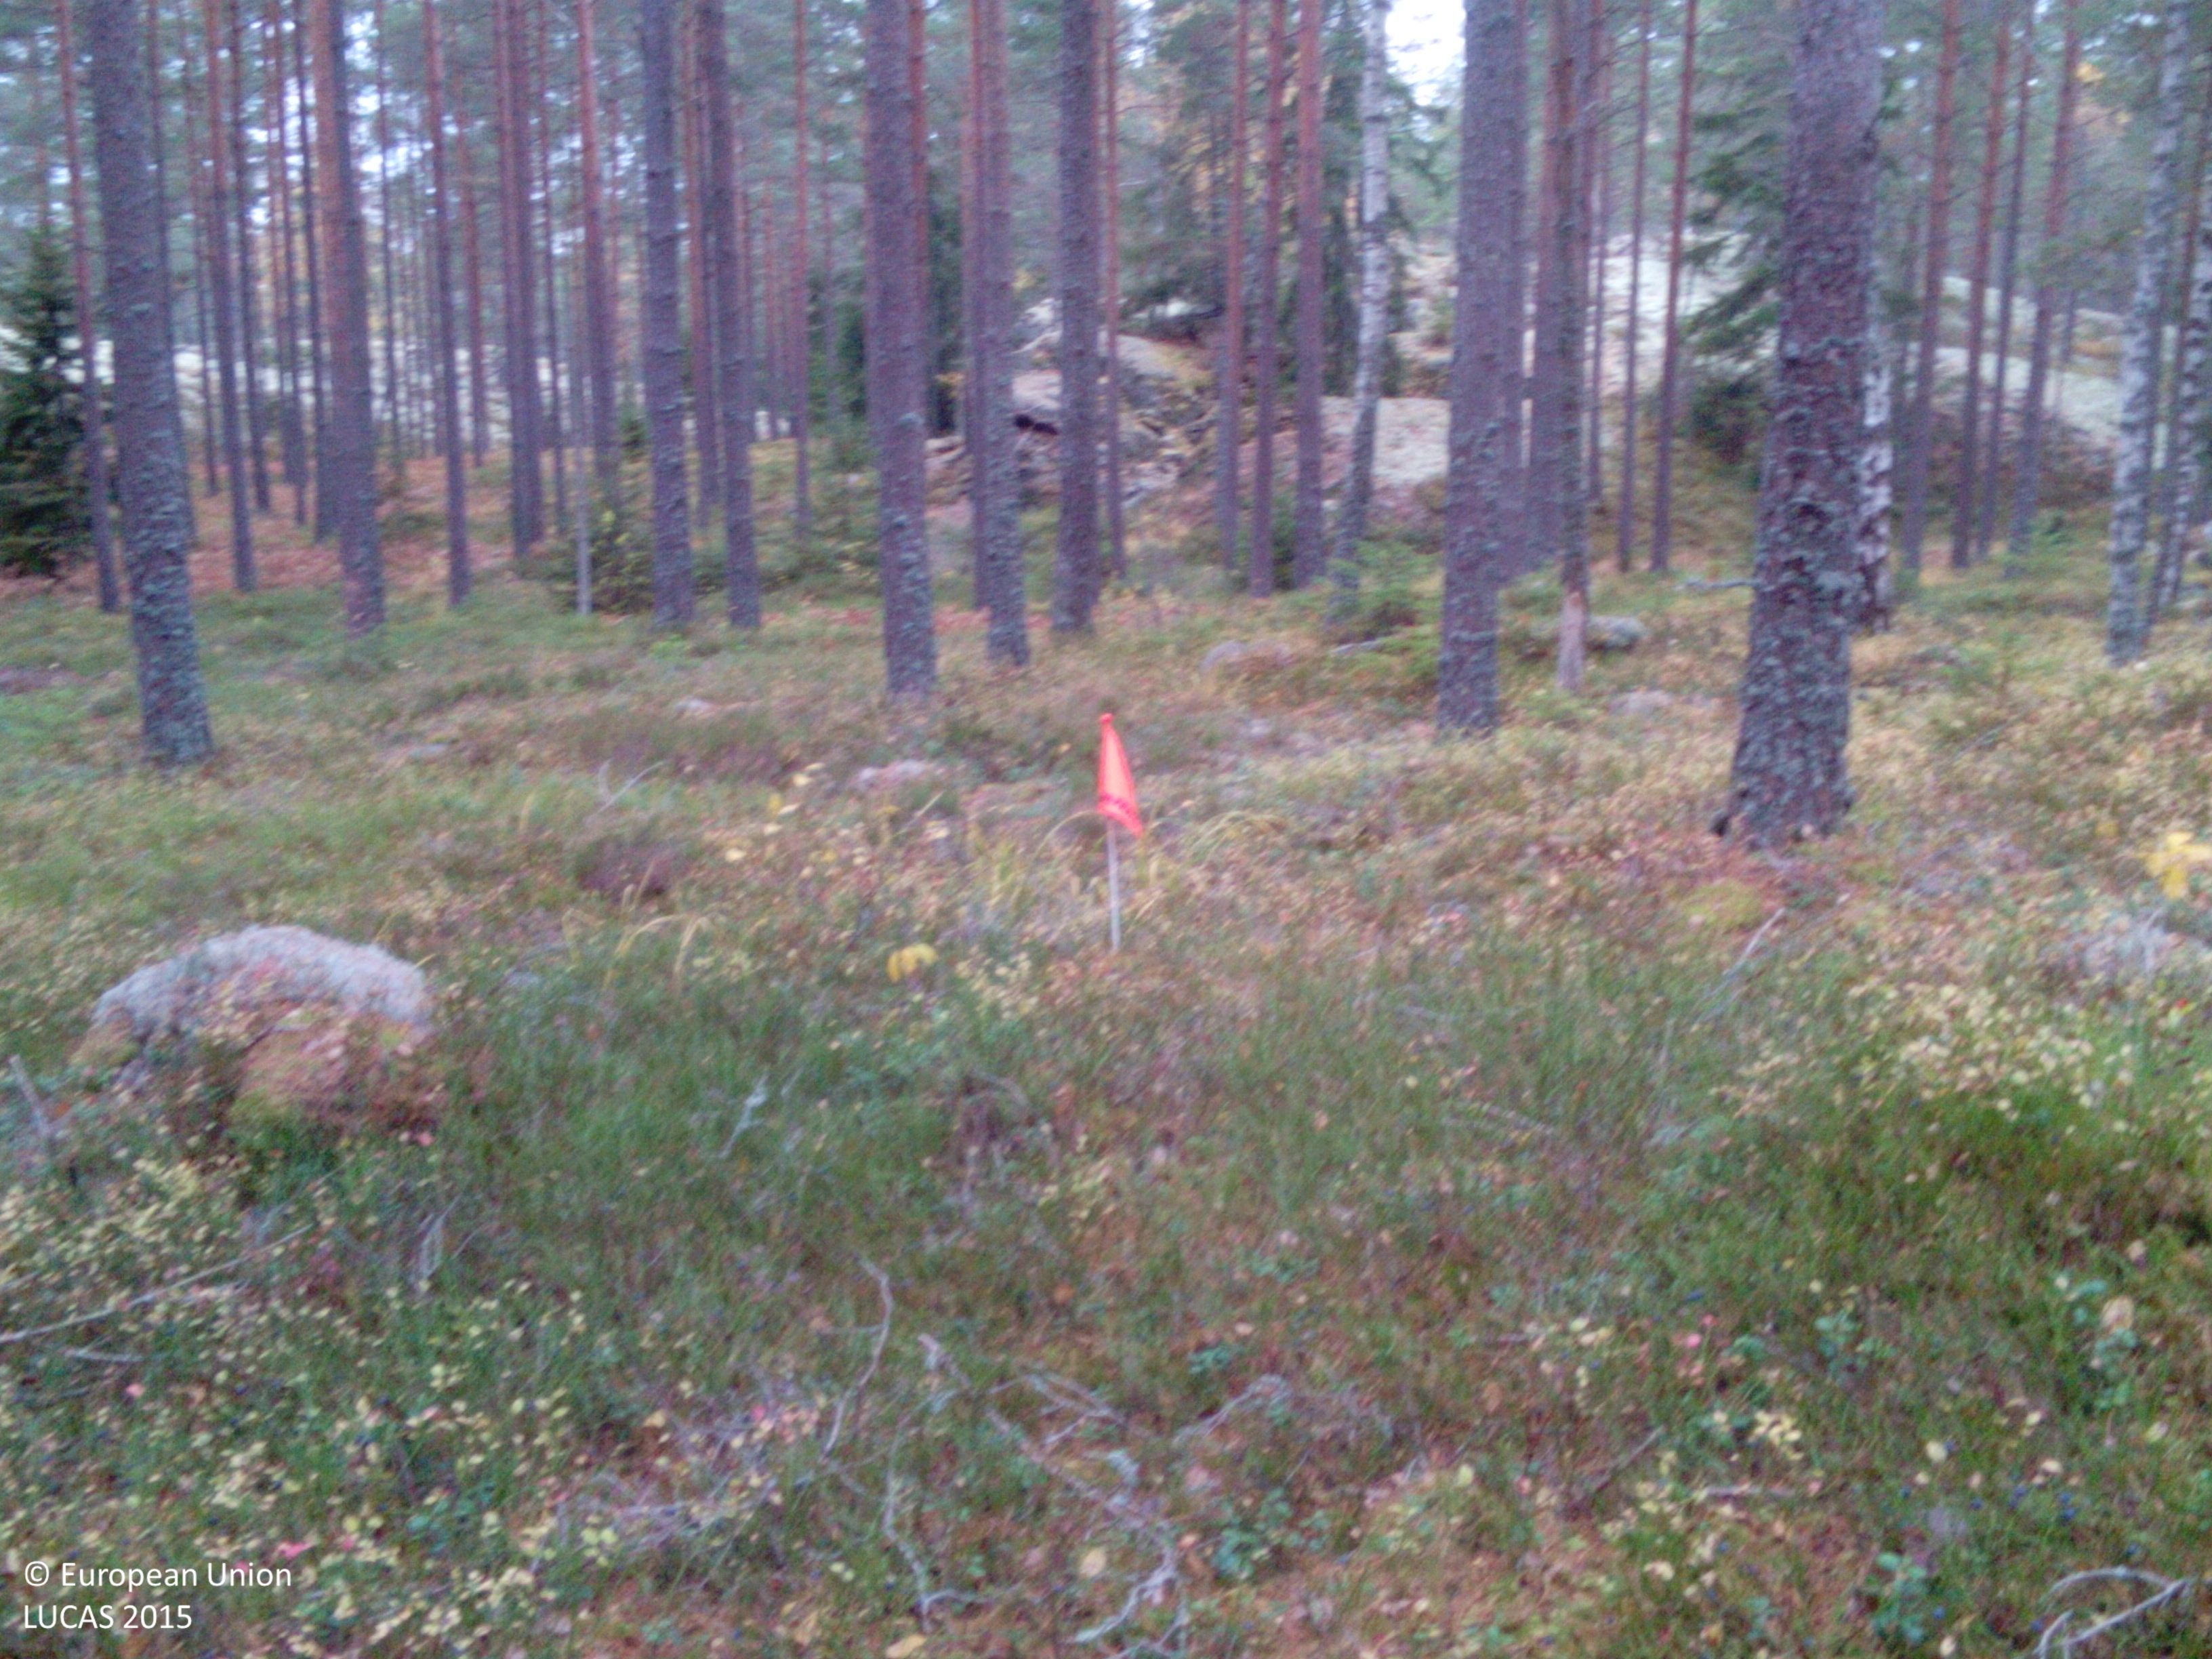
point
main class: Woodland
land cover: Pine dominated coniferous woodland
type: boreal forest
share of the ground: > 75 %
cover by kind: coniferous forest trees 75 %, broadleaved forest trees 10 %, herbaceous plants 10 %, lichens and mosses 5 %
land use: Forestry
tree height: > 5 m
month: October
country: SE
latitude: 59.2068
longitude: 16.3504
